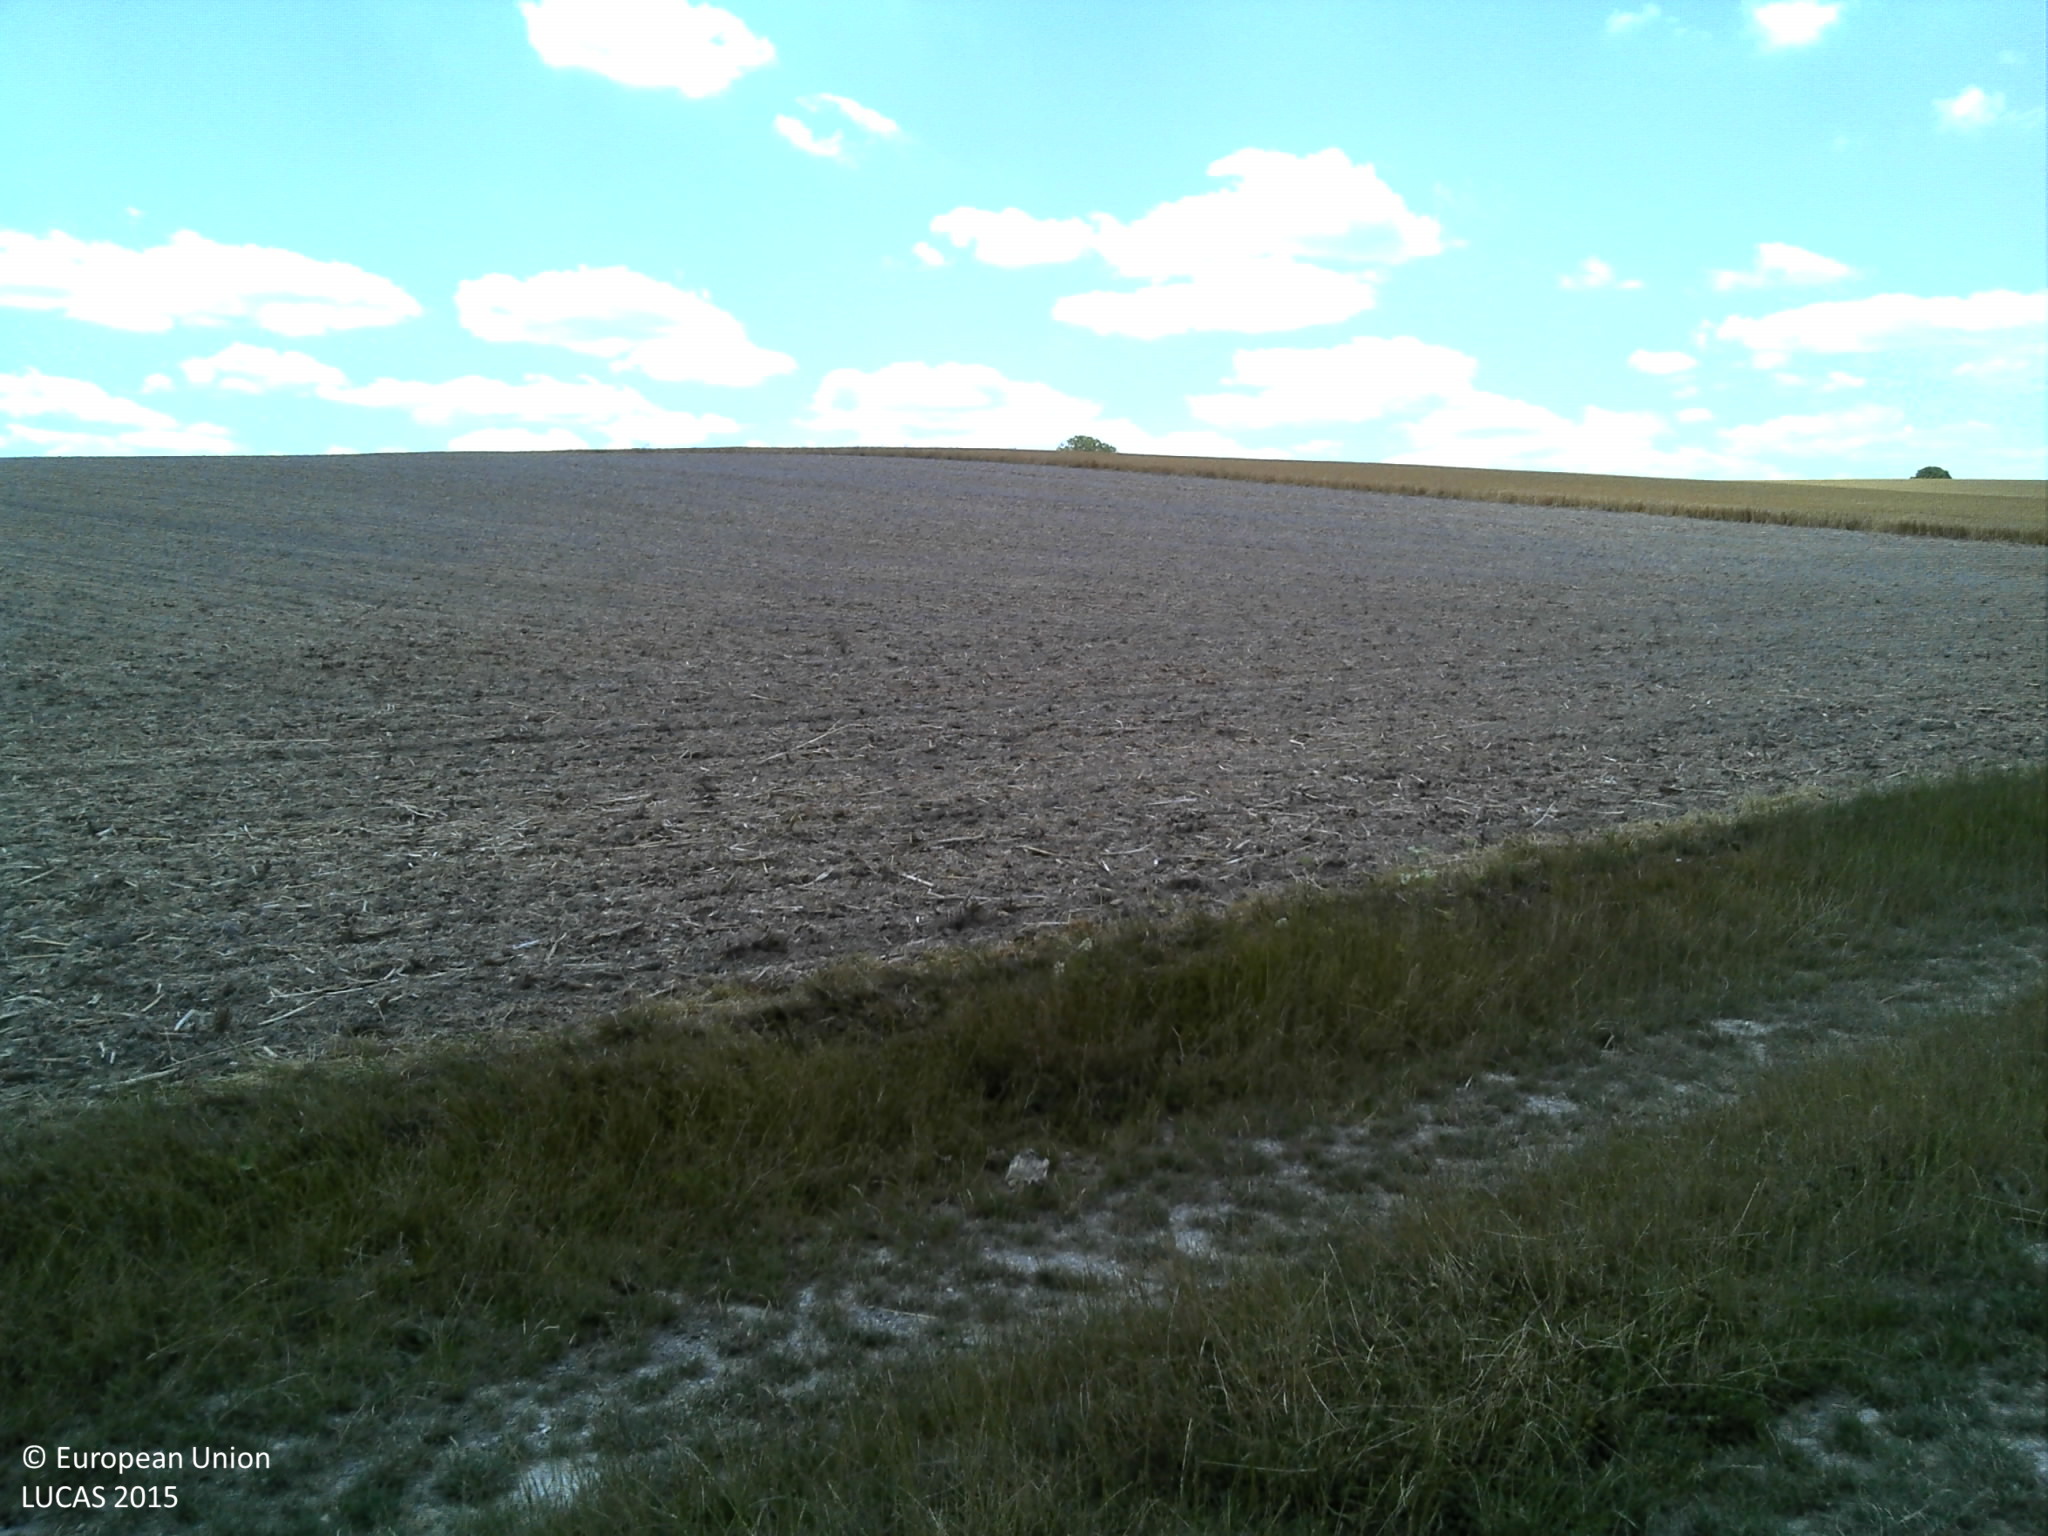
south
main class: Cropland
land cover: Common wheat
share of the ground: > 75 %
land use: Agriculture (excluding fallow land and kitchen gardens)
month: July
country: FR
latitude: 48.8378
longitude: 4.7520
